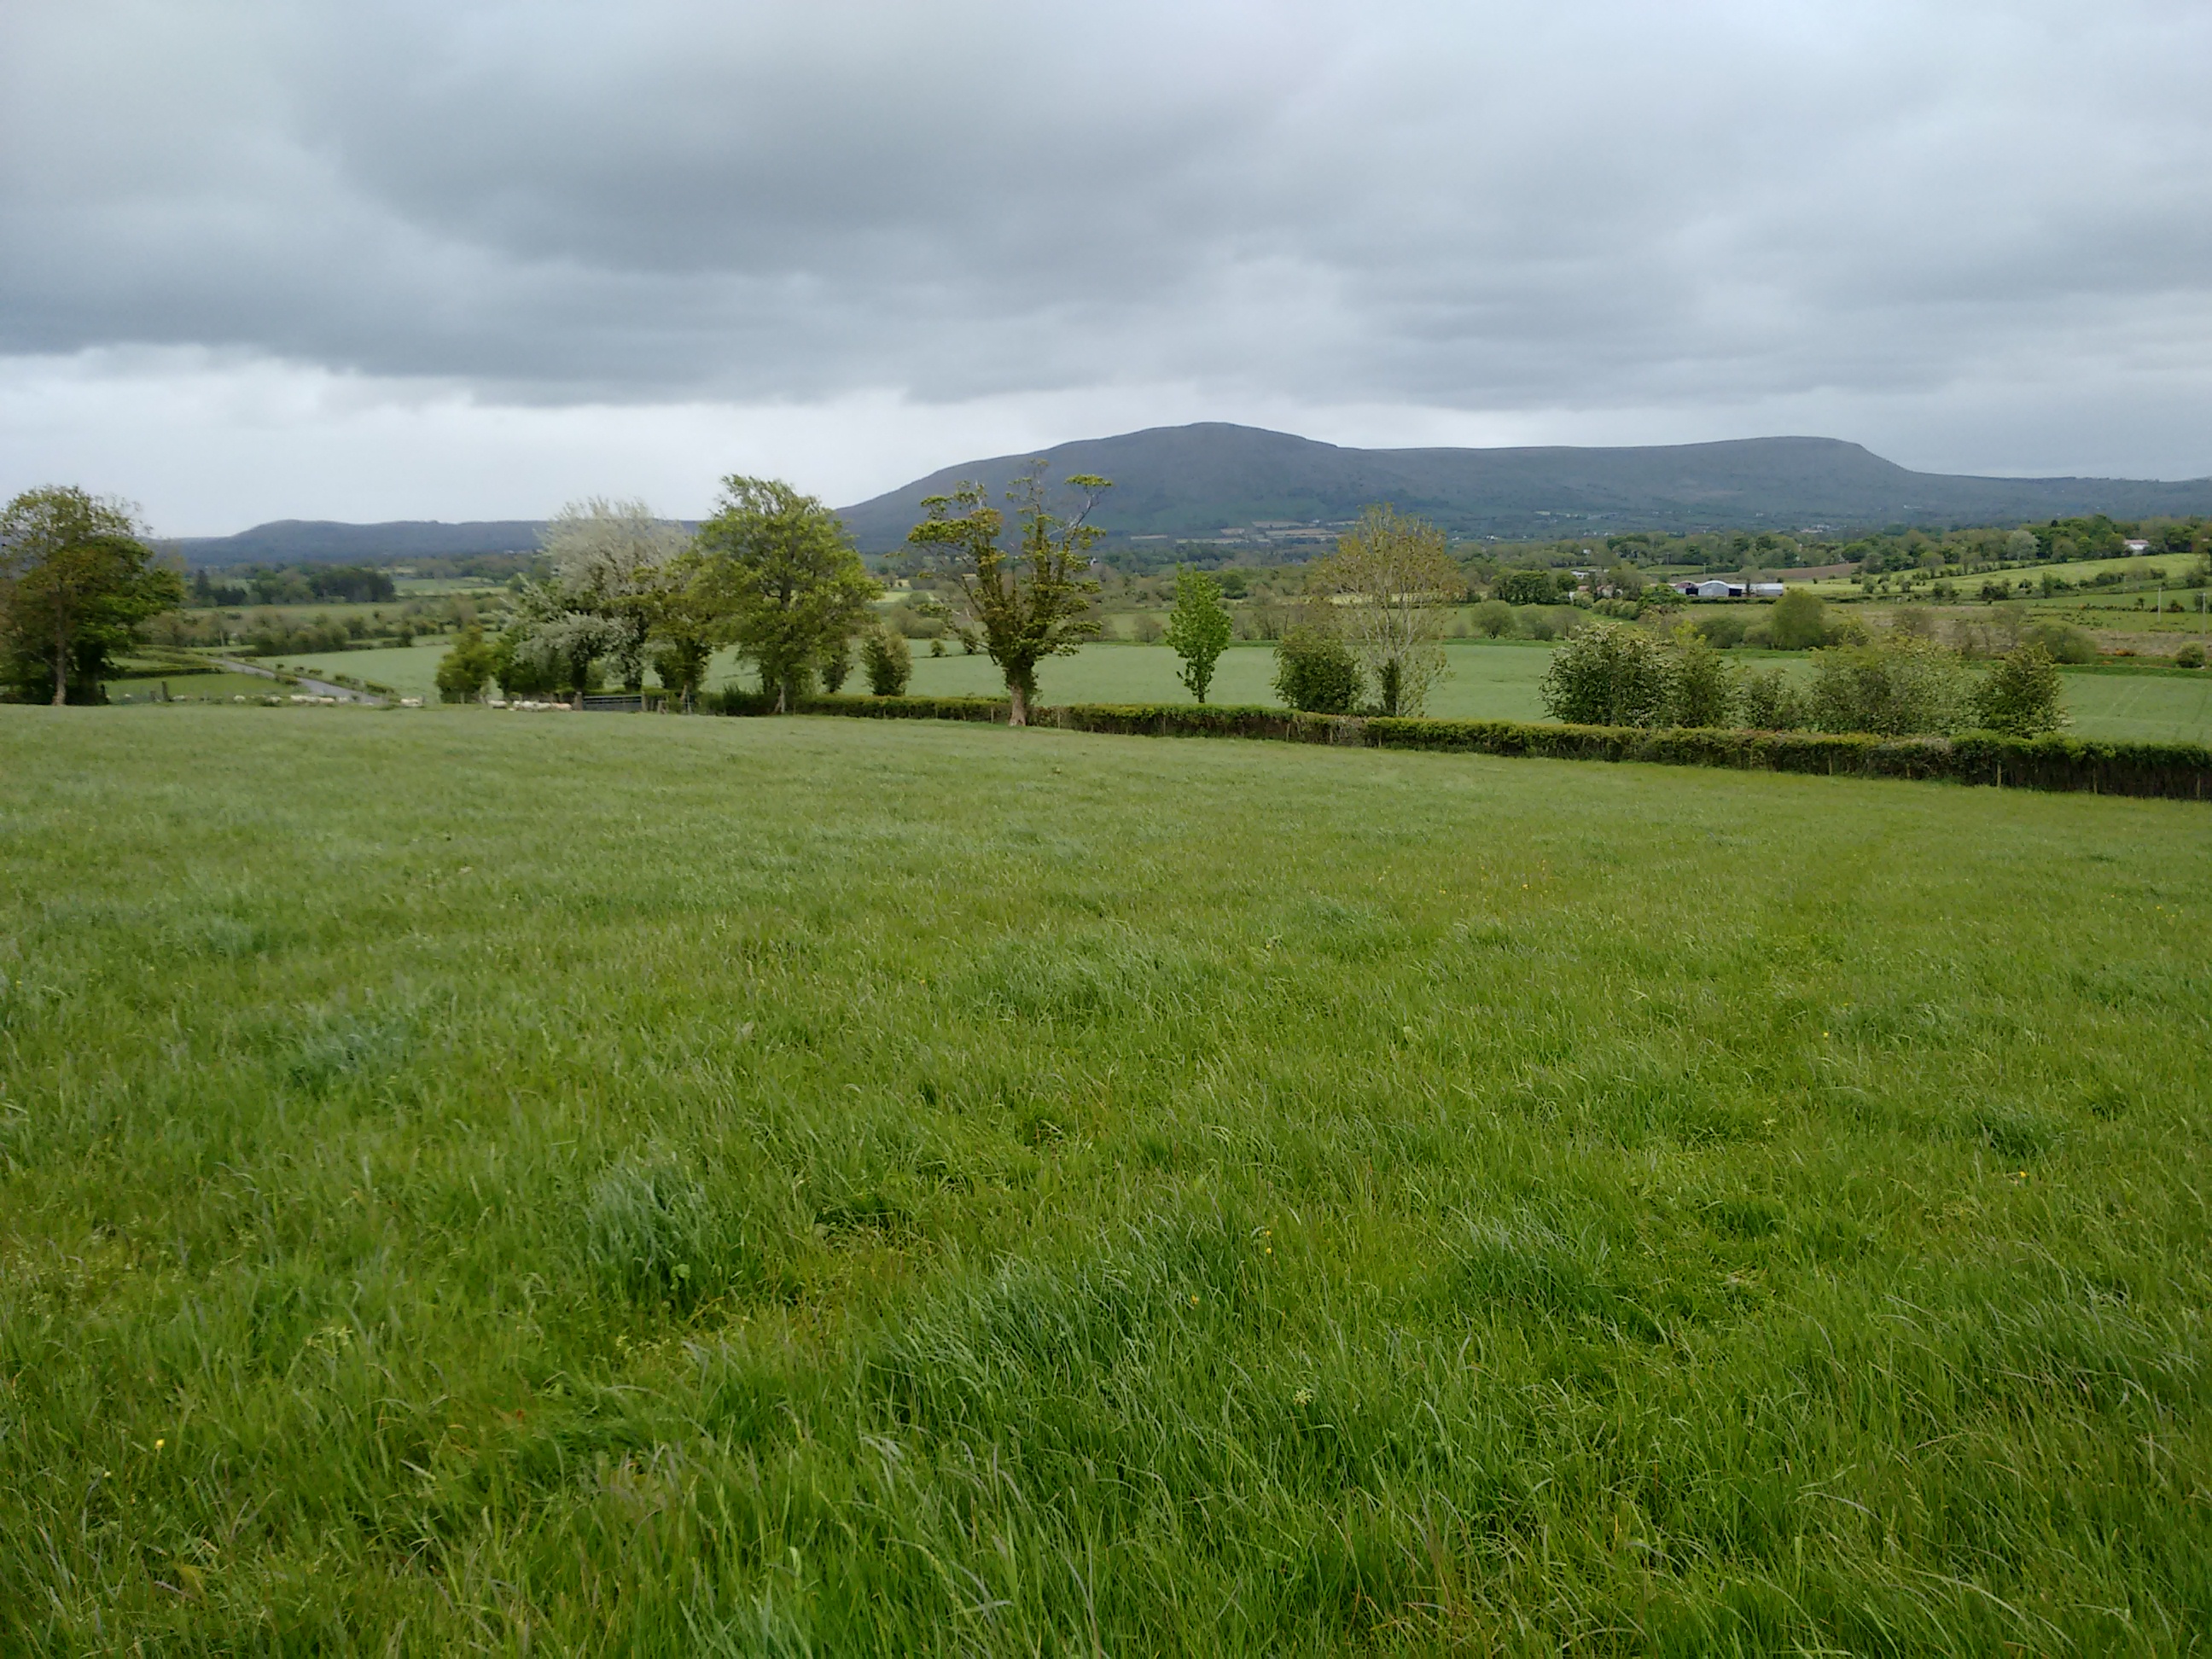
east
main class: Grassland
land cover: Grassland without tree/shrub cover
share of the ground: > 75 %
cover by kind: herbaceous plants 100 %
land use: Agriculture (excluding fallow land and kitchen gardens)
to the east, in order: Grassland without tree/shrub cover; Electric lines; Grassland without tree/shrub cover; Fences; Abandoned hedges; Grass margins; Paved roads, cycling and walking lanes; Fences; Abandoned hedges; Grassland without tree/shrub cover
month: June
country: GB
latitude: 54.9546
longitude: -6.9543
